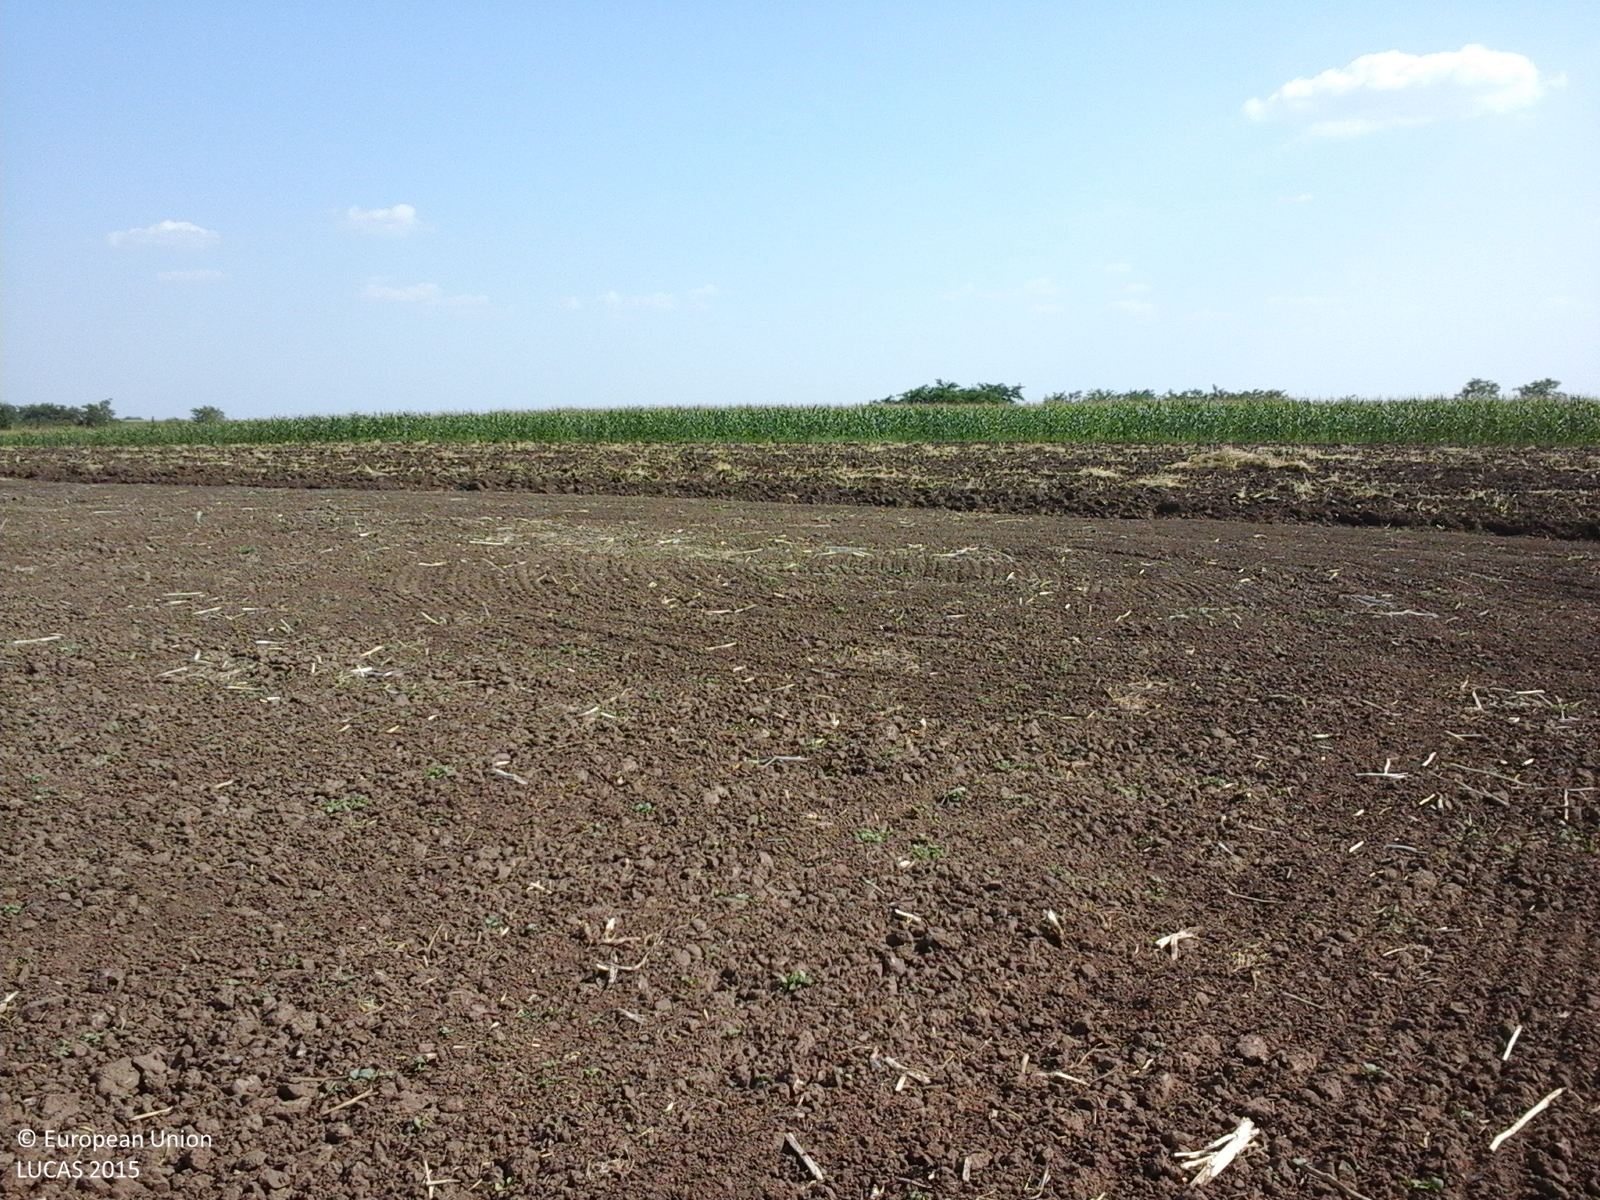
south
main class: Cropland
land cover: Common wheat
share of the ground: < 10 %
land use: Agriculture (excluding fallow land and kitchen gardens)
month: July
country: RO
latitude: 44.9036
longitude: 27.2240
